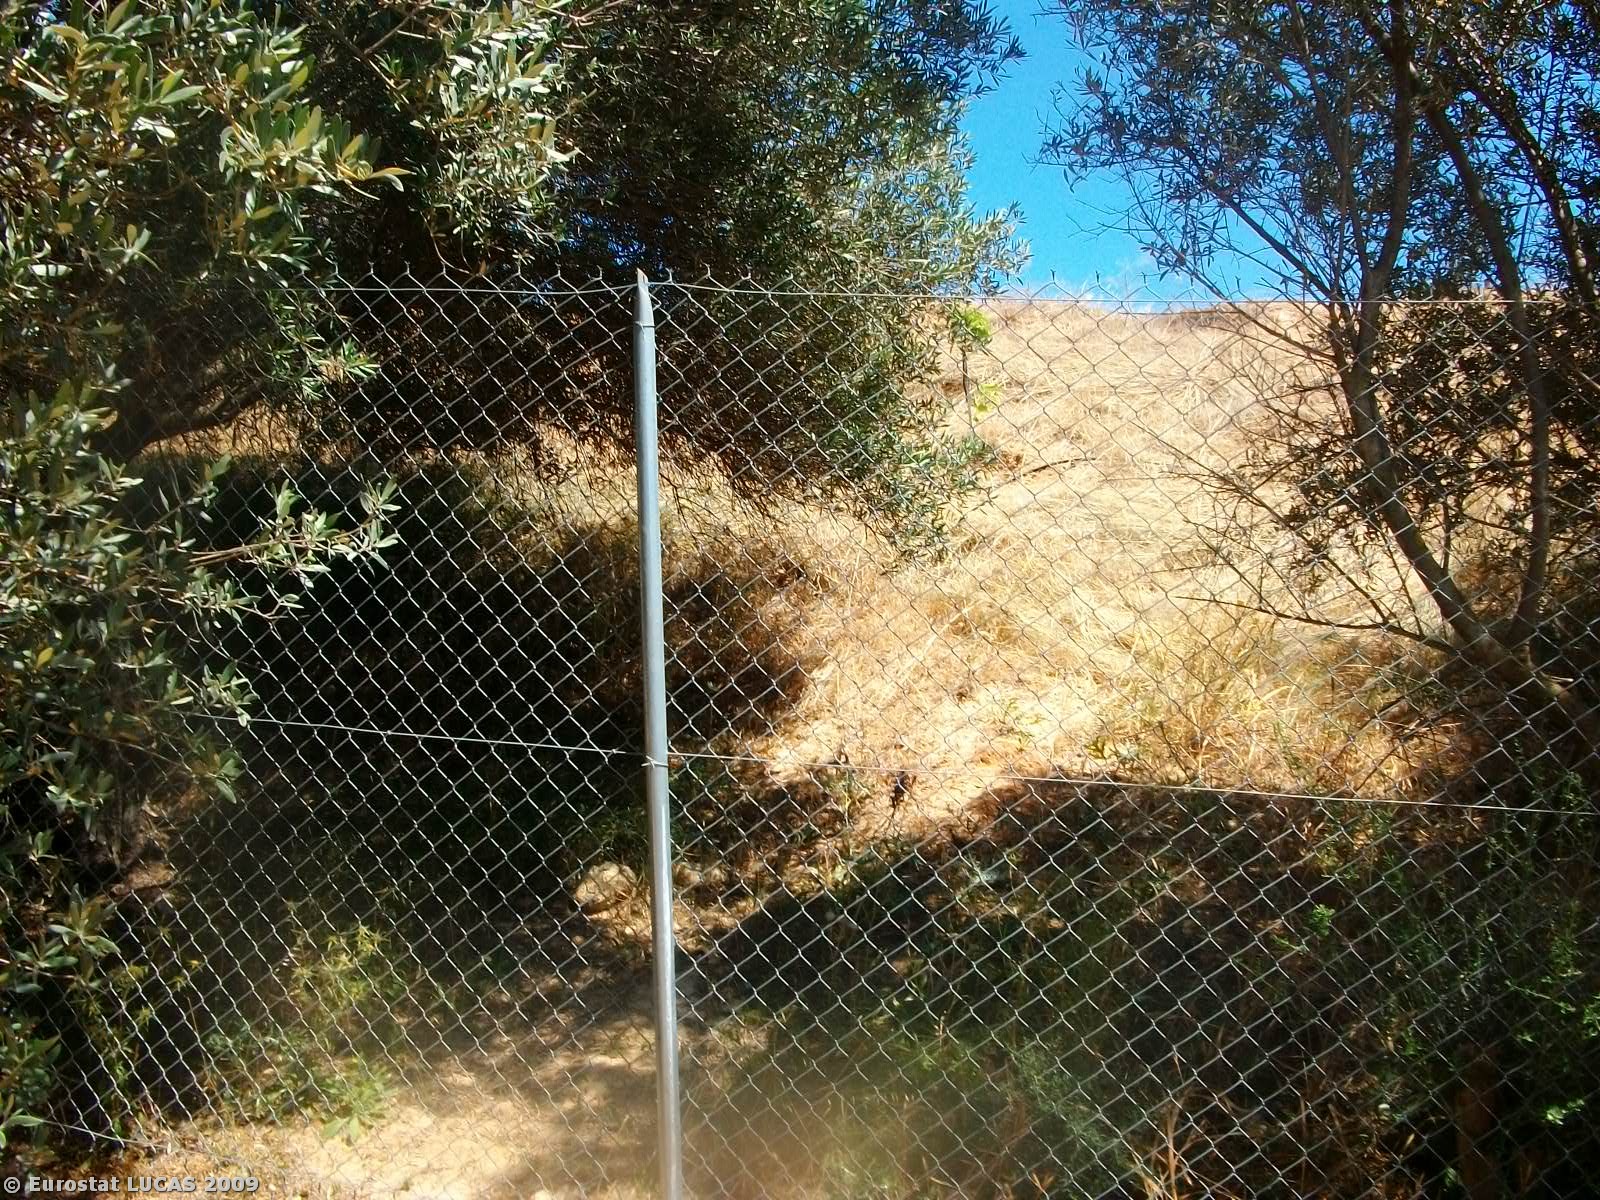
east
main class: Cropland
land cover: Olive groves
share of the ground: 50 - 75 %
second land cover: Bare land
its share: > 75 %
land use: Agriculture (excluding fallow land and kitchen gardens)
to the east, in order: Olive groves; Bare land; Fences; Olive groves; Bare land; Artificial constructions in urban areas; Shrubland with sparse tree cover; Olive groves; Grassland with sparse tree/shrub cover
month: June
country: GR
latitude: 35.0473
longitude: 24.8393
